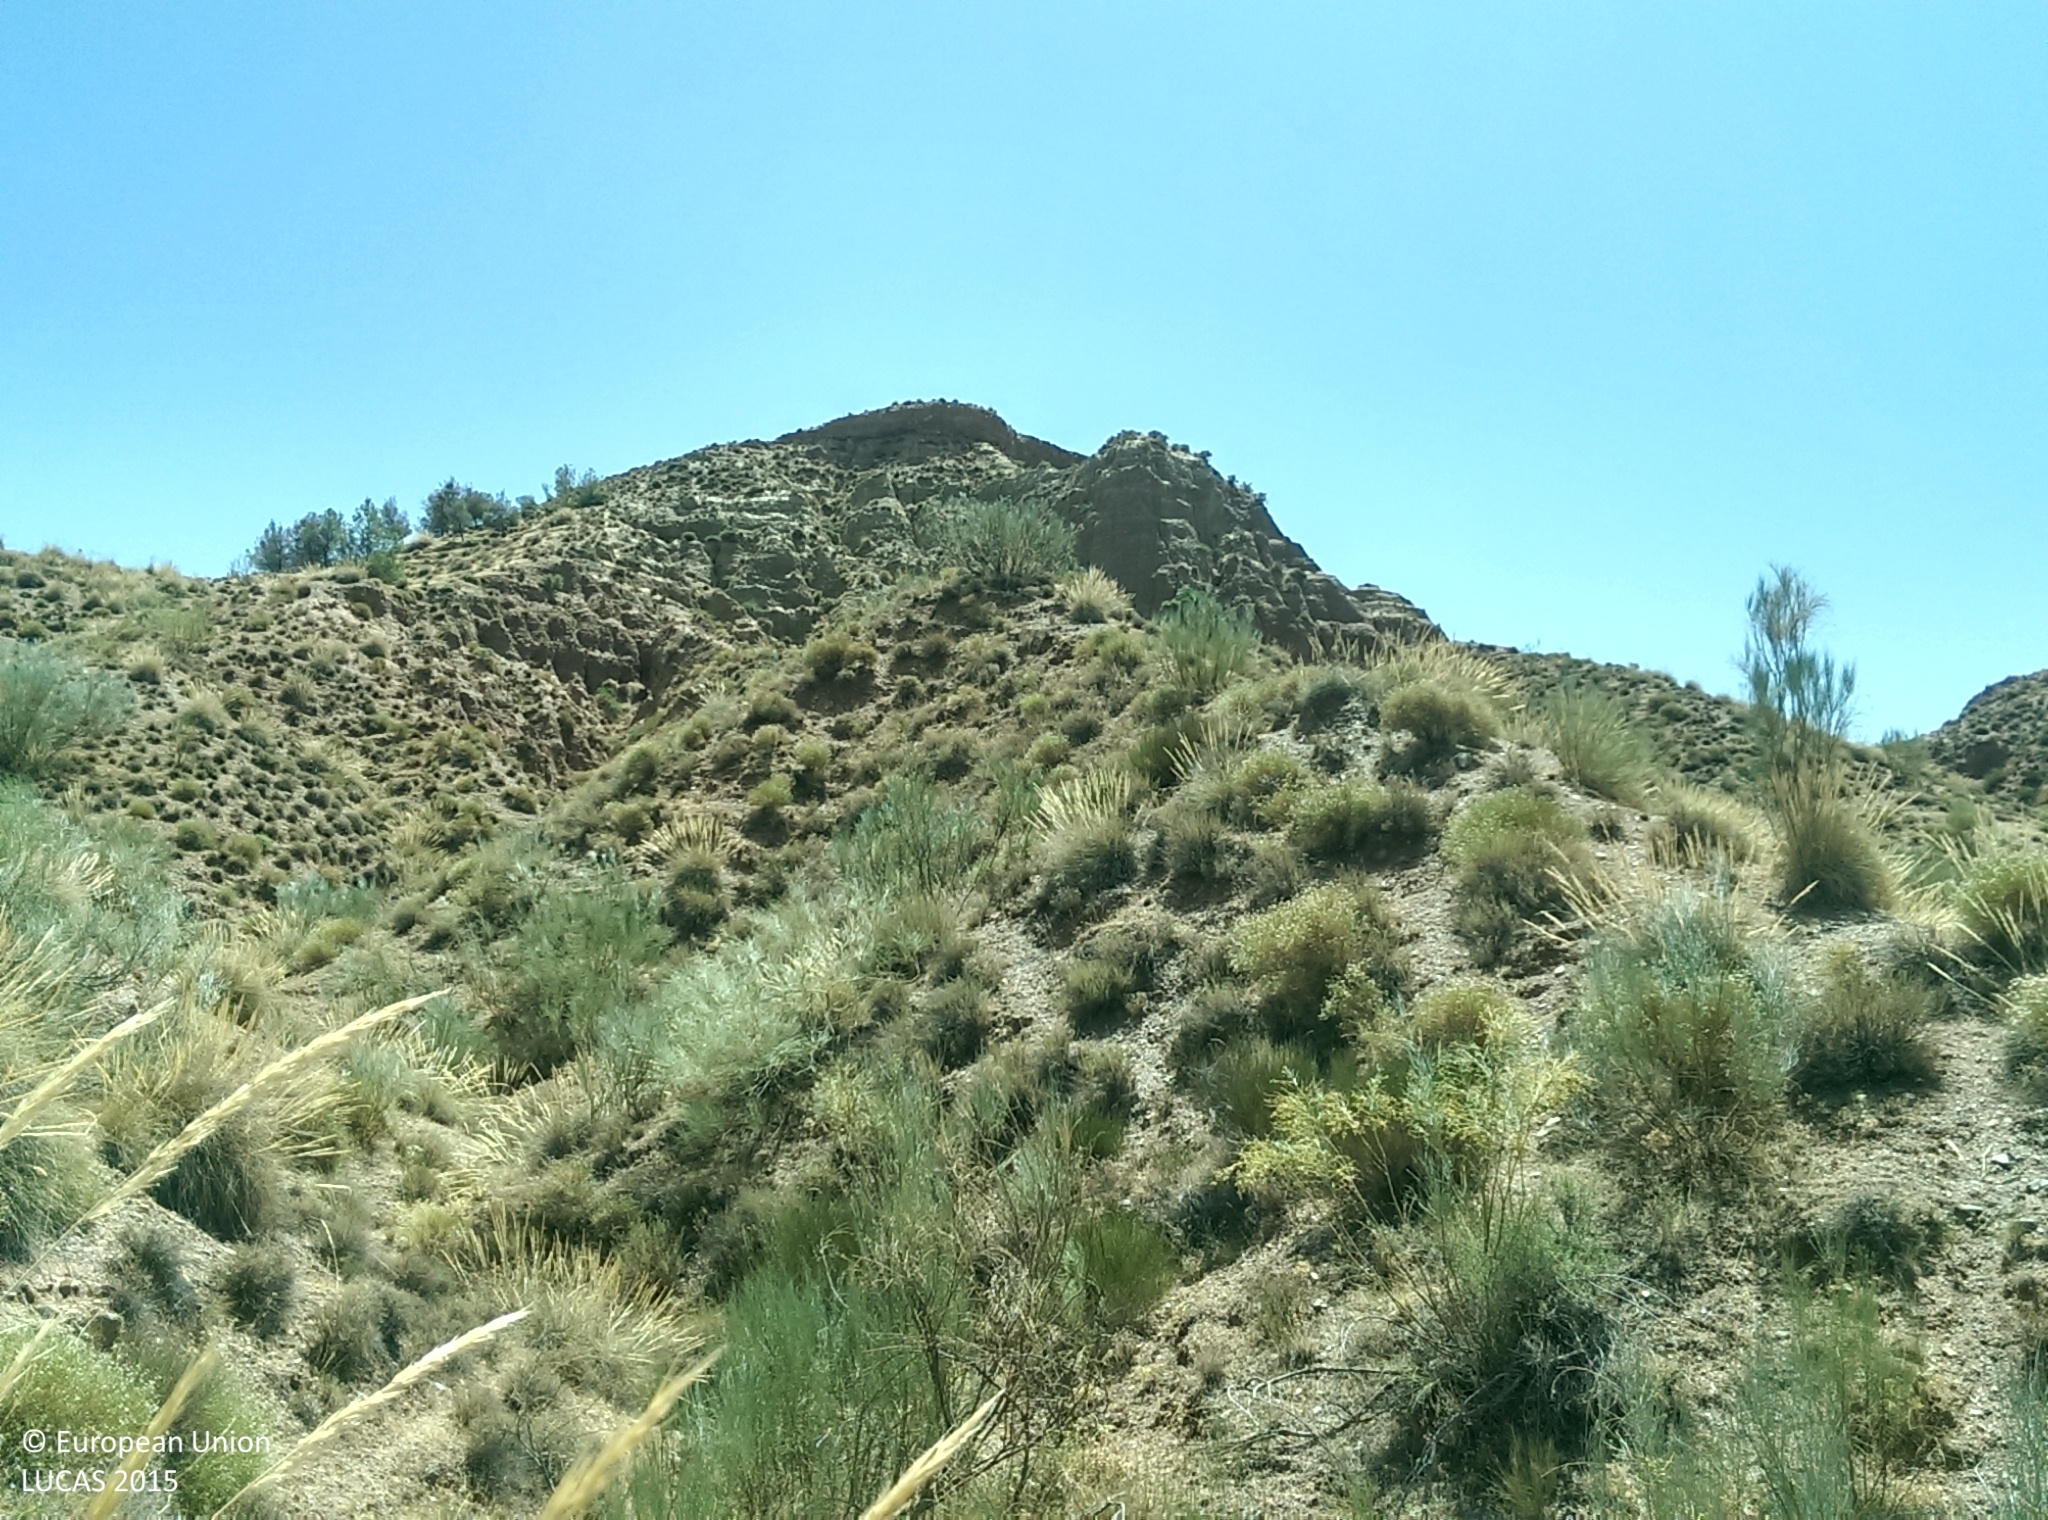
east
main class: Grassland
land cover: Grassland without tree/shrub cover
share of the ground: 50 - 75 %
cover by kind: herbaceous plants 70 %, unconsolidated bare surface 25 %, shrubs 5 %
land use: Semi-natural and natural areas not in use
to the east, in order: Grassland without tree/shrub cover; Pine dominated coniferous woodland; Shrubland without tree cover
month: July
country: ES
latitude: 37.2794
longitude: -3.2170
